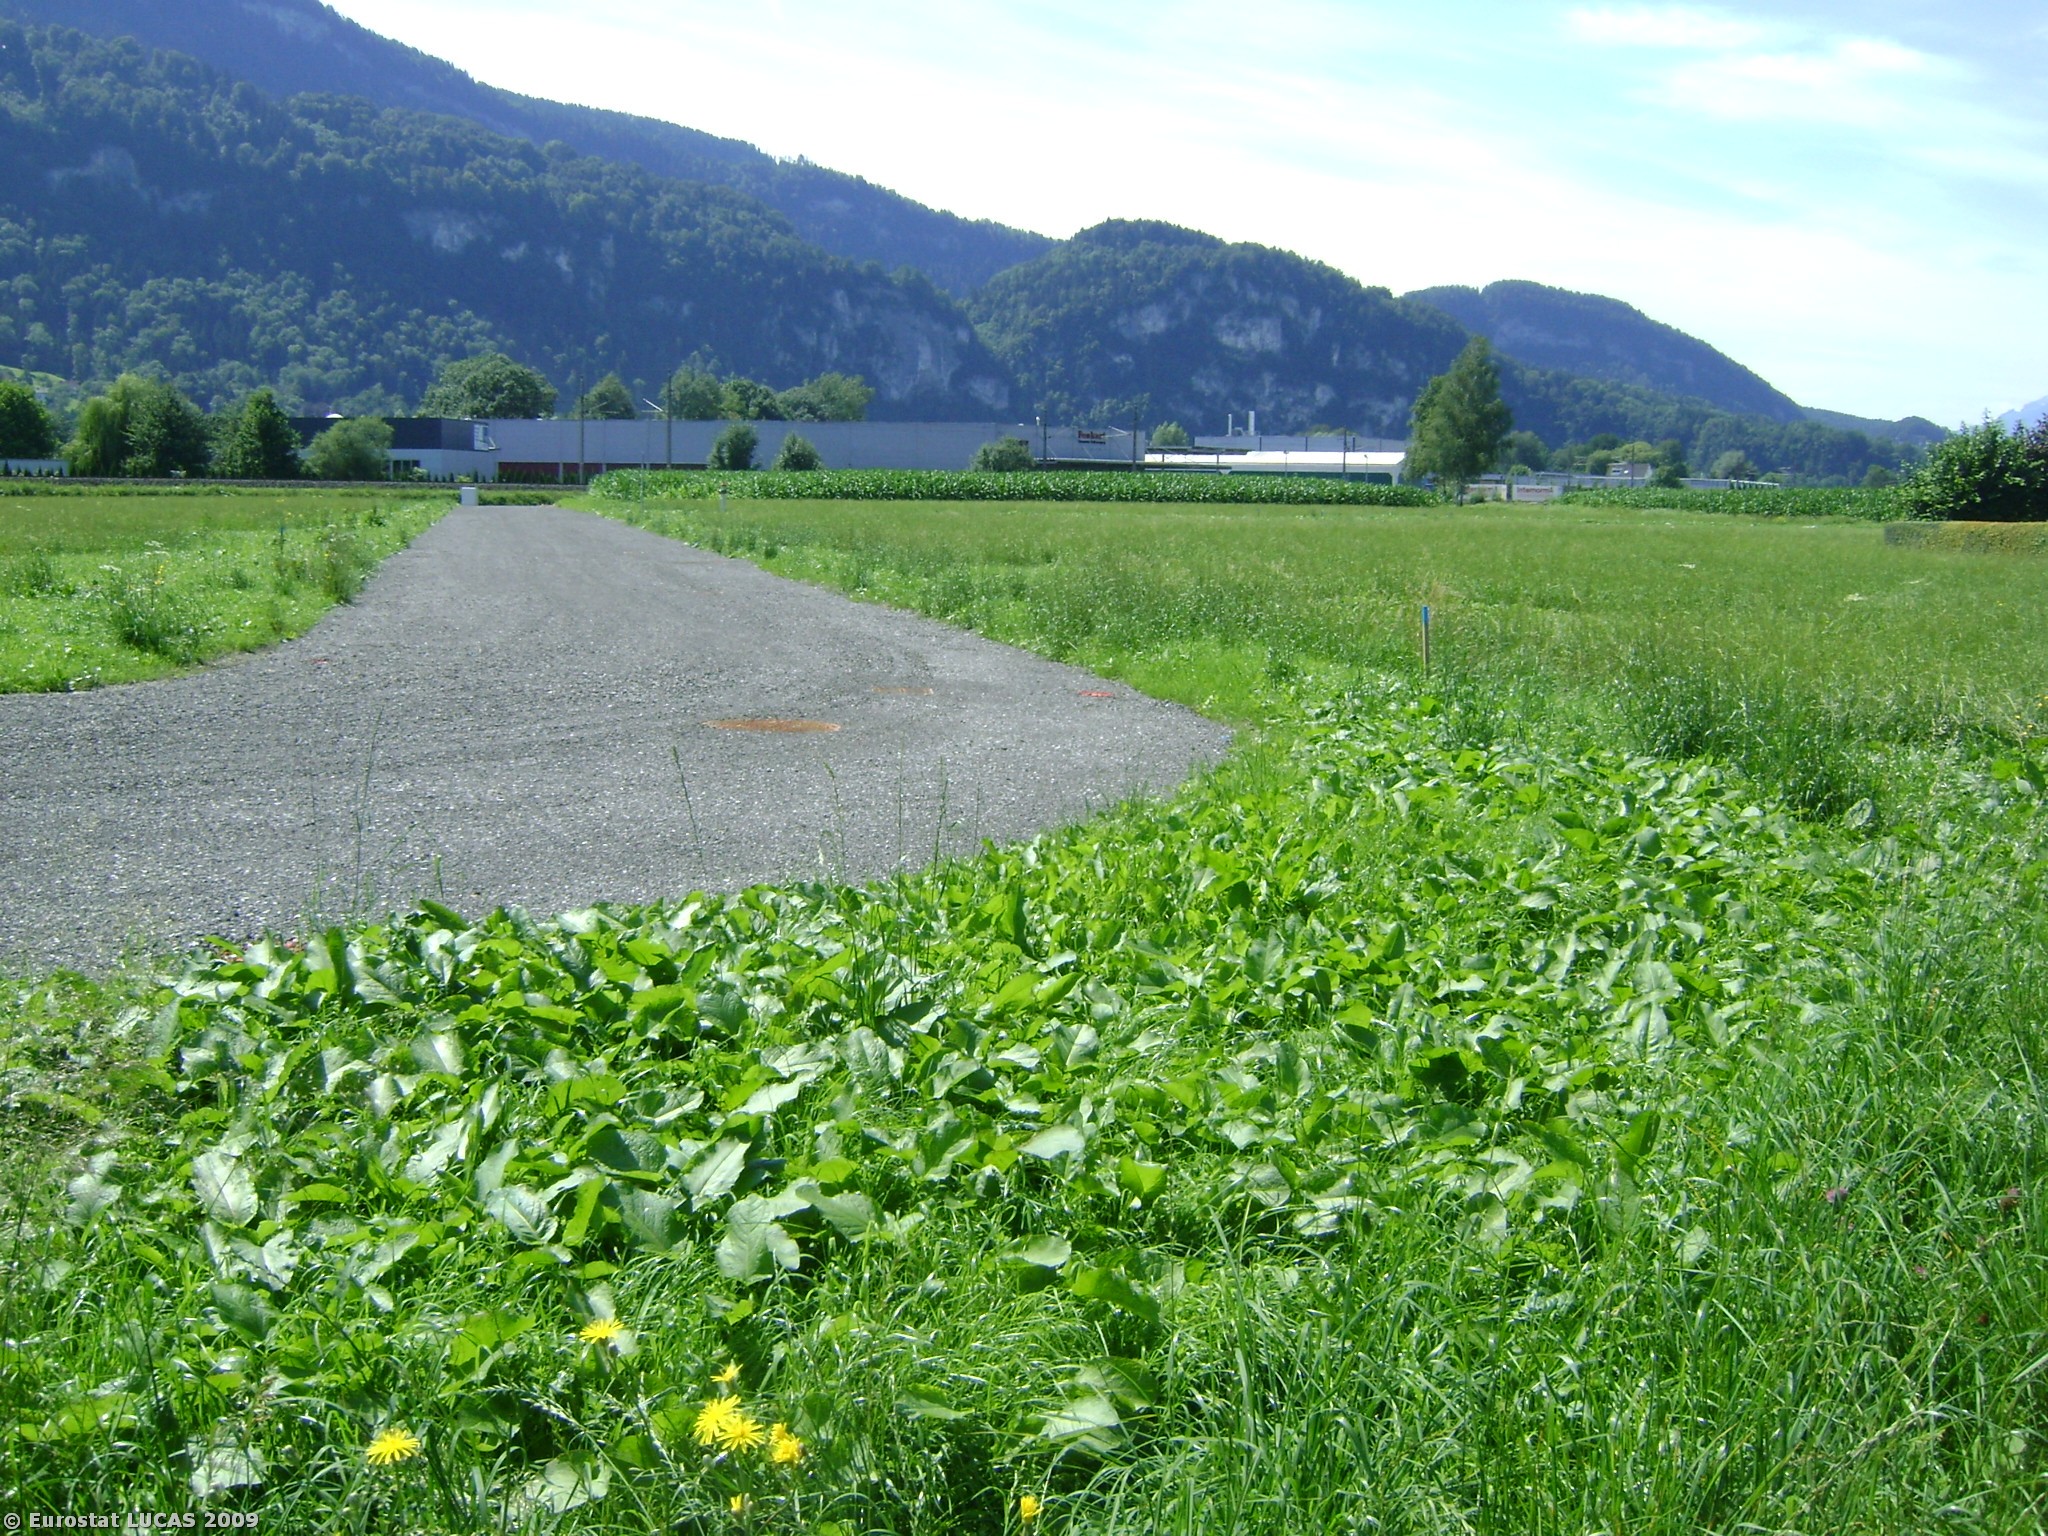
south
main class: Grassland
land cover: Grassland without tree/shrub cover
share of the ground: > 75 %
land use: Agriculture (excluding fallow land and kitchen gardens)
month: July
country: AT
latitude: 47.3591
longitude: 9.6693
